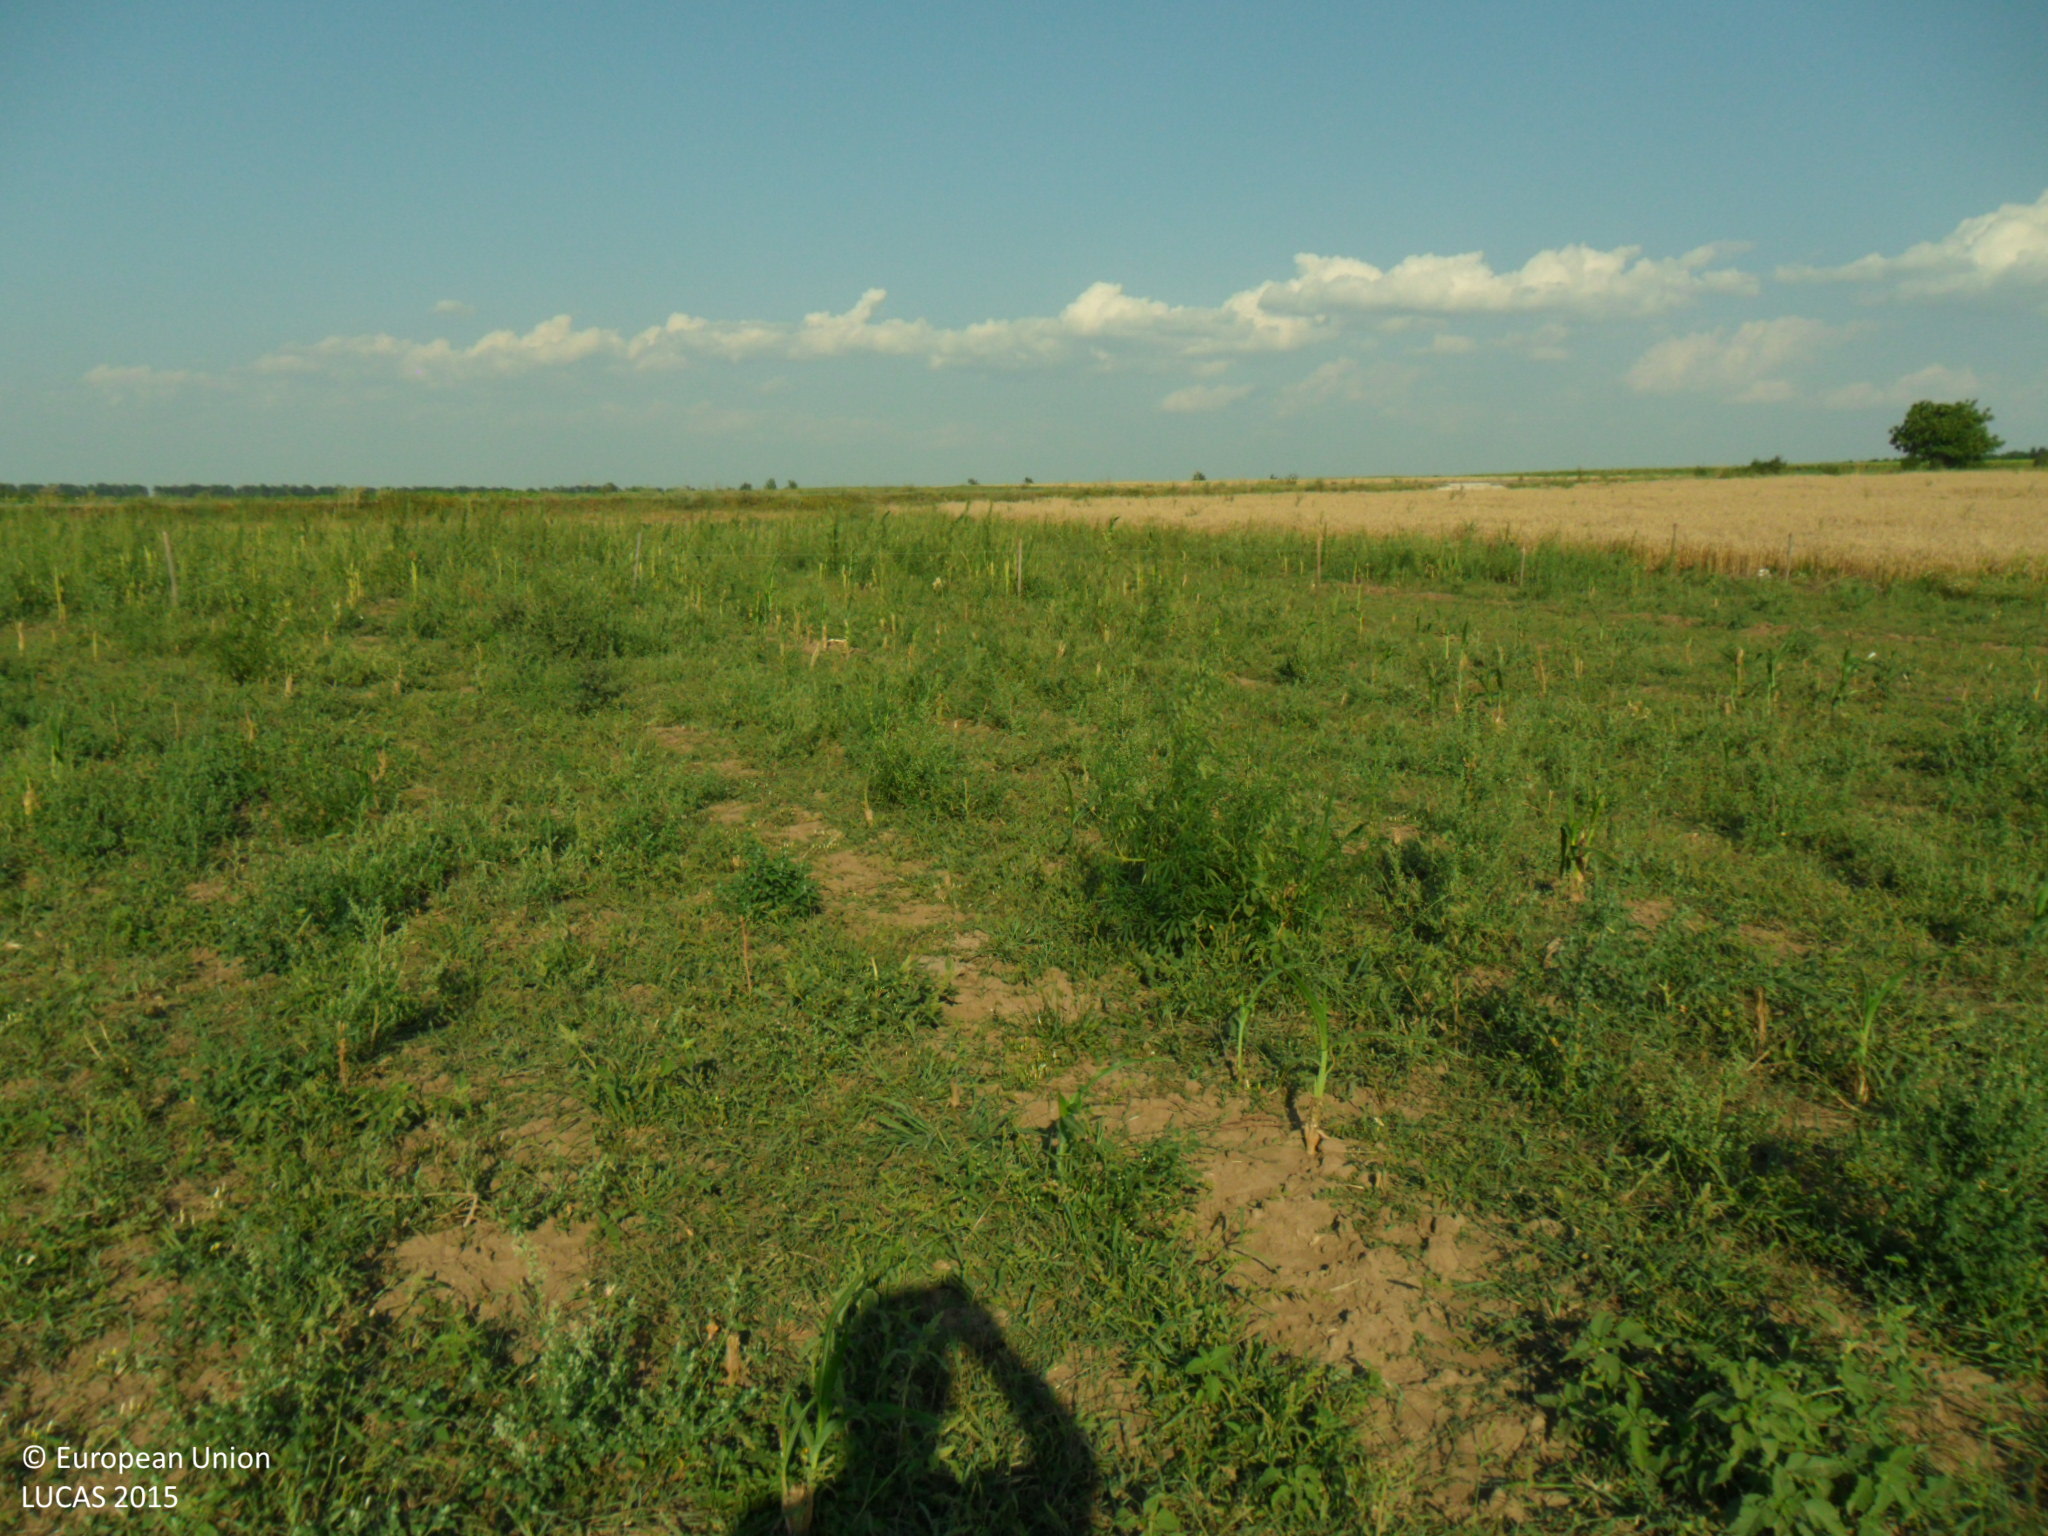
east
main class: Cropland
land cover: Maize
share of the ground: 10 - 25 %
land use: Agriculture (excluding fallow land and kitchen gardens)
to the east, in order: Maize; Tracks; Grass margins; Paved roads, cycling and walking lanes; Grass margins; Tracks; Lucerne
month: July
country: BG
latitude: 43.6942
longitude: 27.0828
